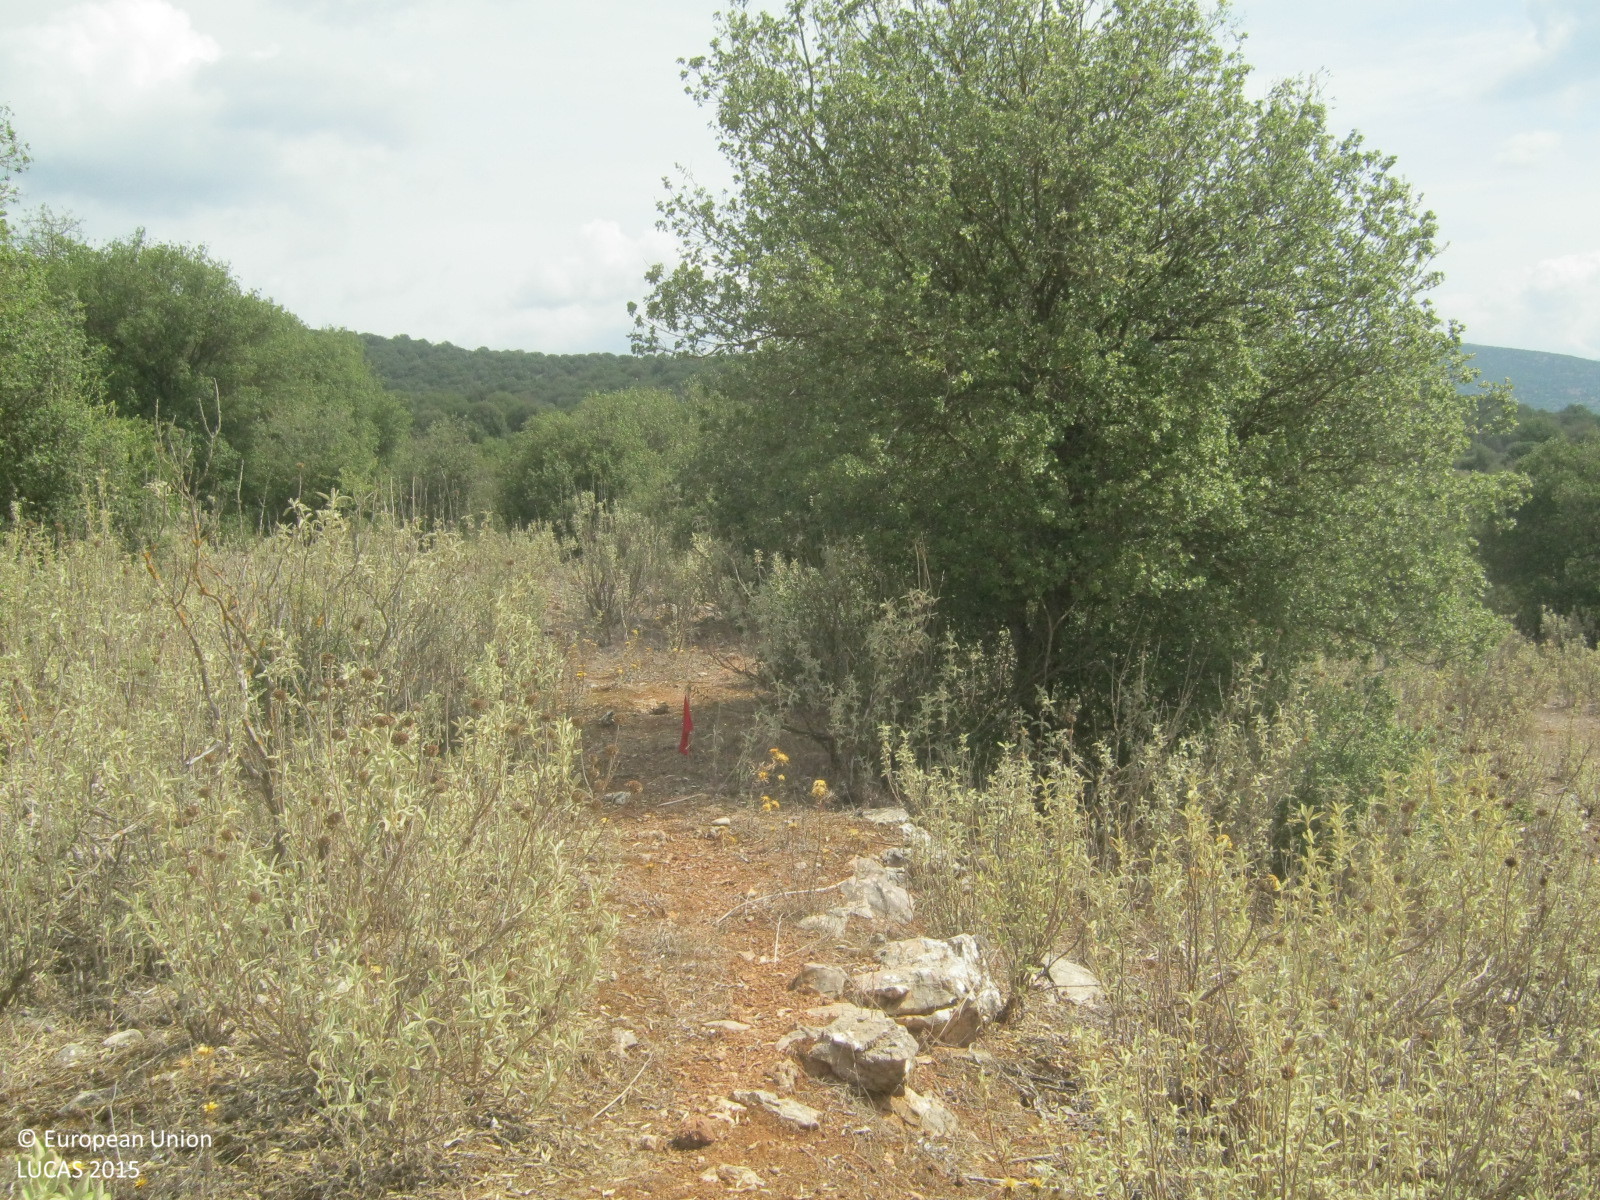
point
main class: Grassland
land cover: Grassland with sparse tree/shrub cover
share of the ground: 50 - 75 %
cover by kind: herbaceous plants 50 %, unconsolidated bare surface 35 %, shrubs 10 %, broadleaved forest trees 5 %
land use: Agriculture (excluding fallow land and kitchen gardens)
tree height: < 5 m
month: September
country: GR
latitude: 37.8370
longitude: 22.0657
